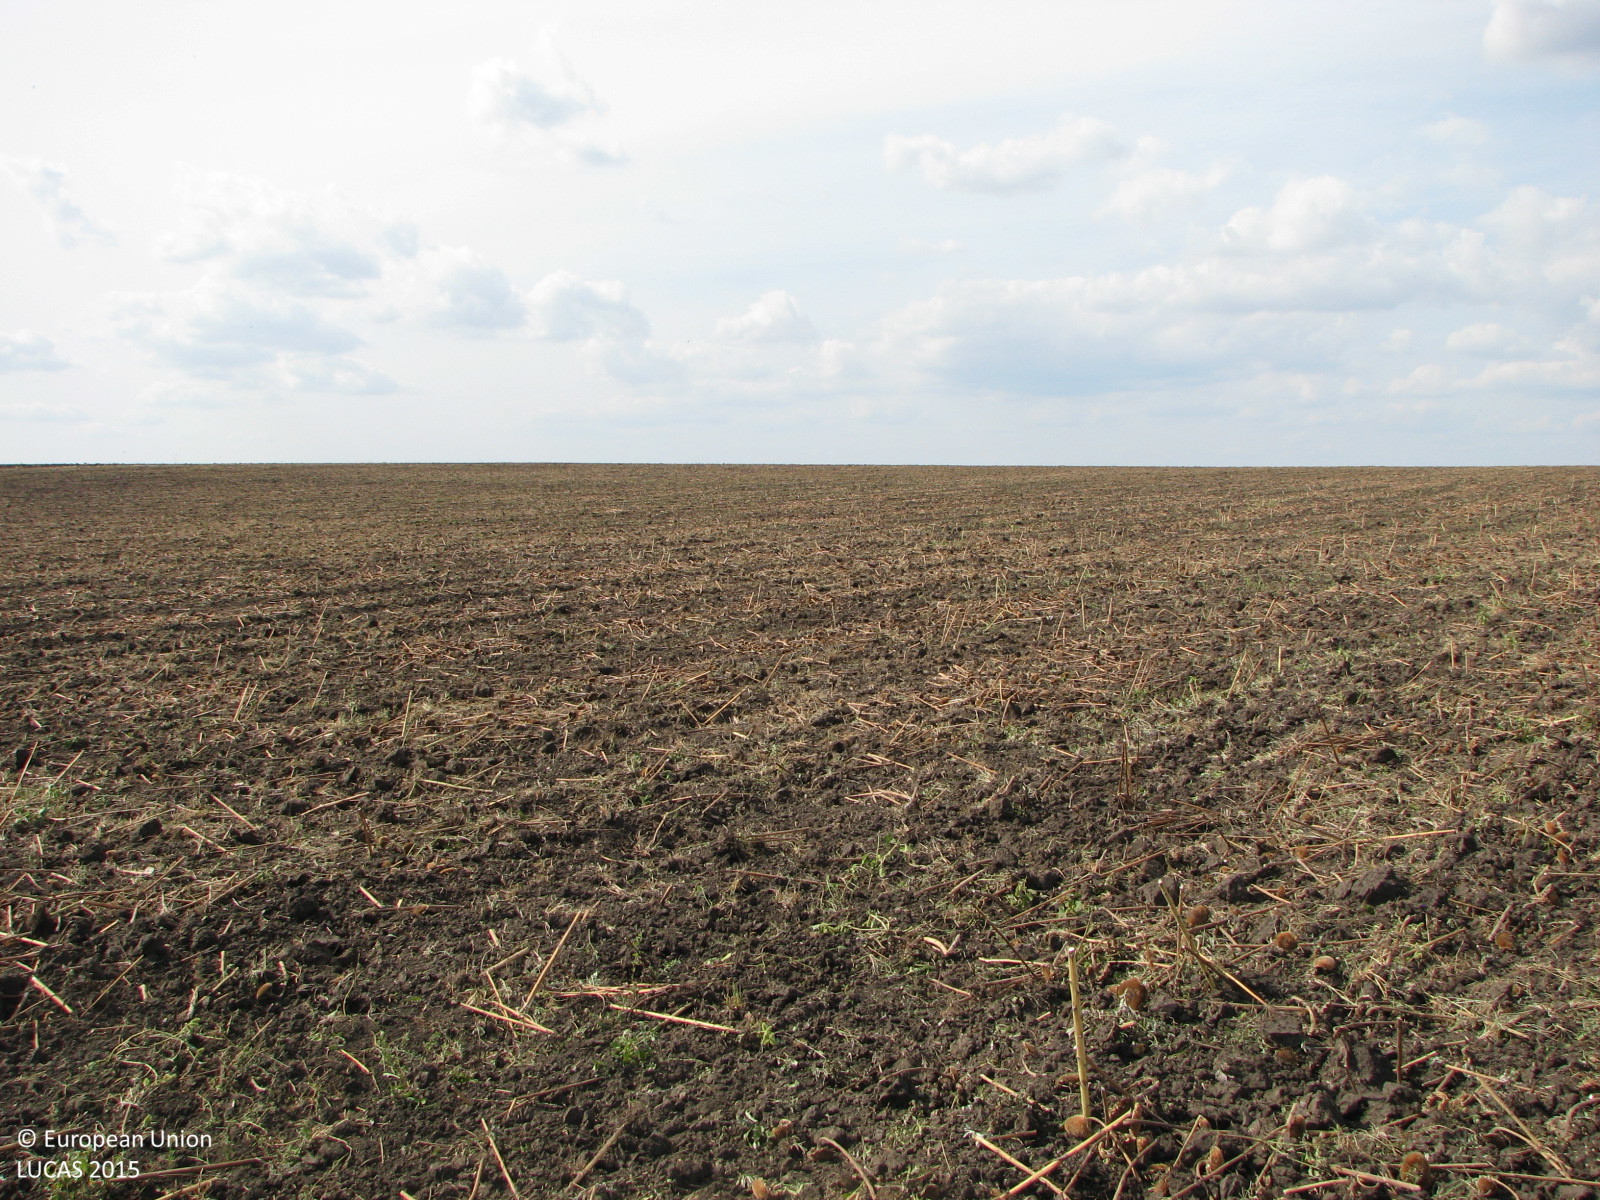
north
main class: Cropland
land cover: Sunflower
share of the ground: < 10 %
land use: Agriculture (excluding fallow land and kitchen gardens)
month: September
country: BG
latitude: 42.4938
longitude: 26.7804
